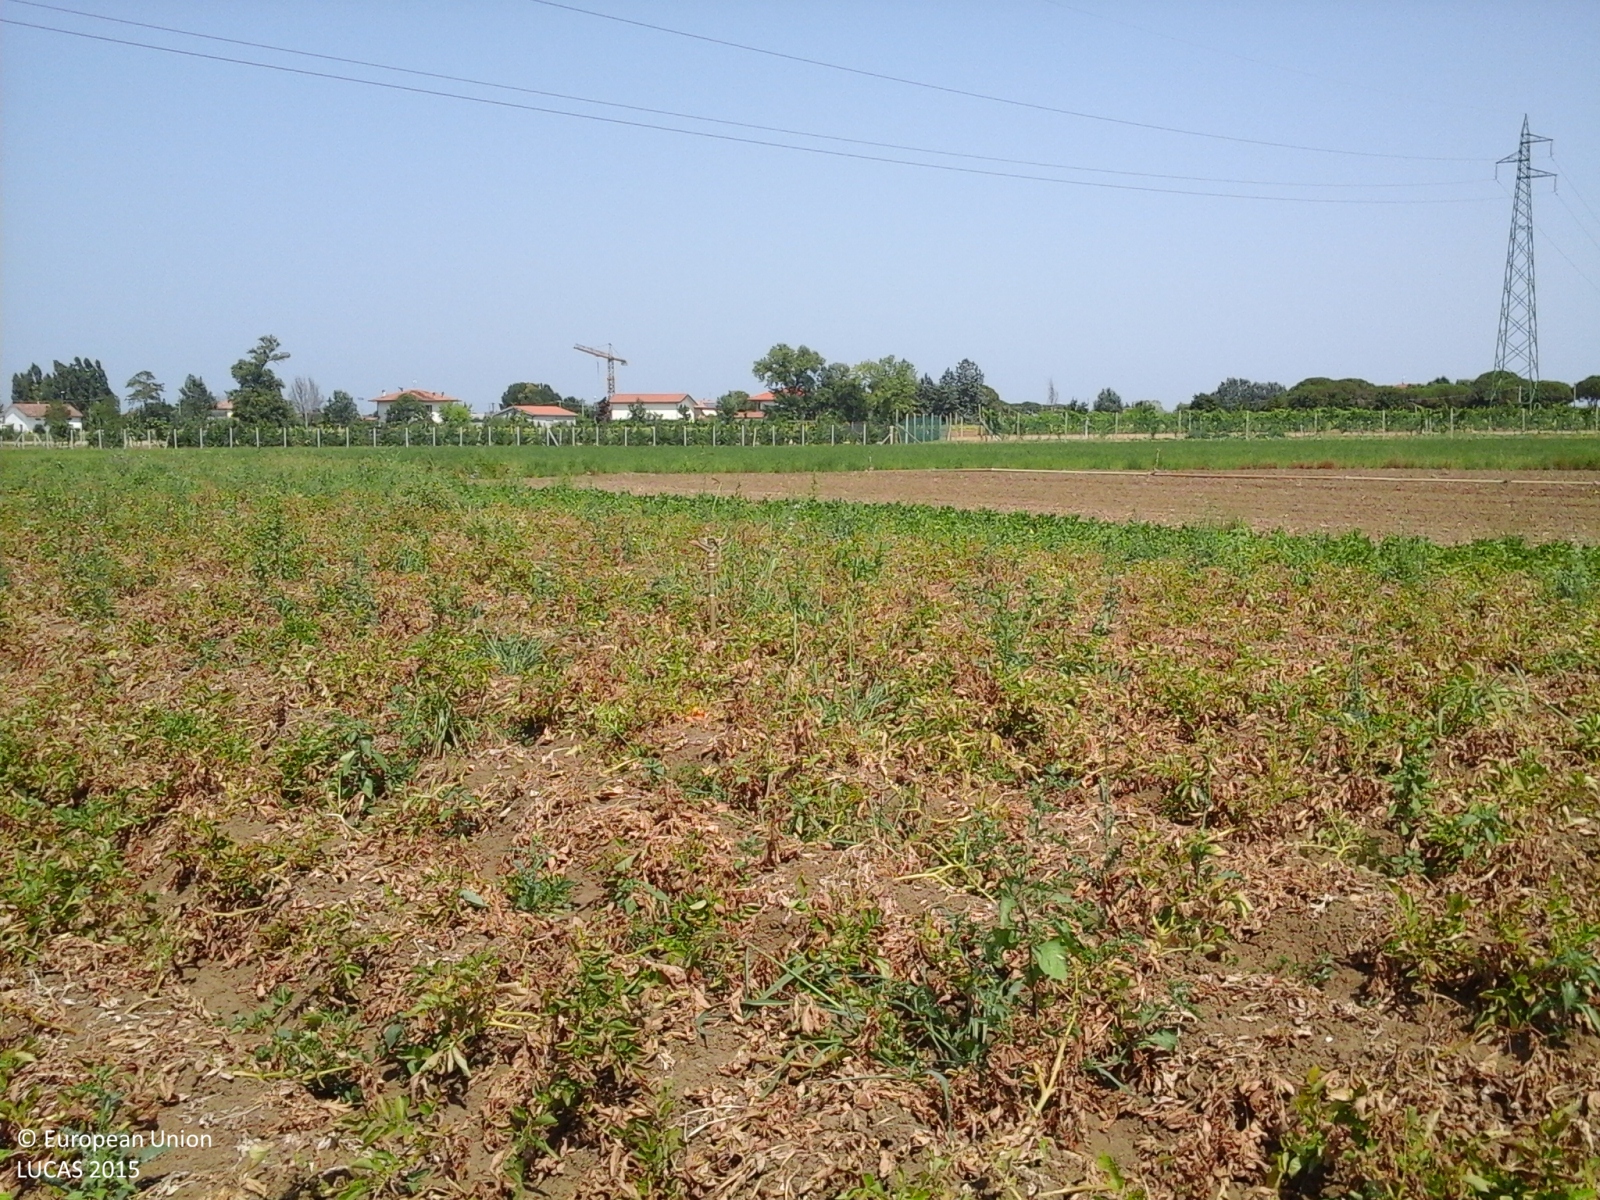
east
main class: Cropland
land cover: Potatoes
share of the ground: > 75 %
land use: Agriculture (excluding fallow land and kitchen gardens)
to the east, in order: Potatoes; Dry pulses; Ditches and canals; Other fresh vegetables; Ditches and canals; Lucerne; Electric lines; Lucerne; Fences; Other fresh vegetables; Vineyards; Ditches and canals; Fences; Tracks; Ditches and canals; Common wheat; Ditches and canals; Common wheat; Sunflower
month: July
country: IT
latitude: 44.1416
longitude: 12.4322
